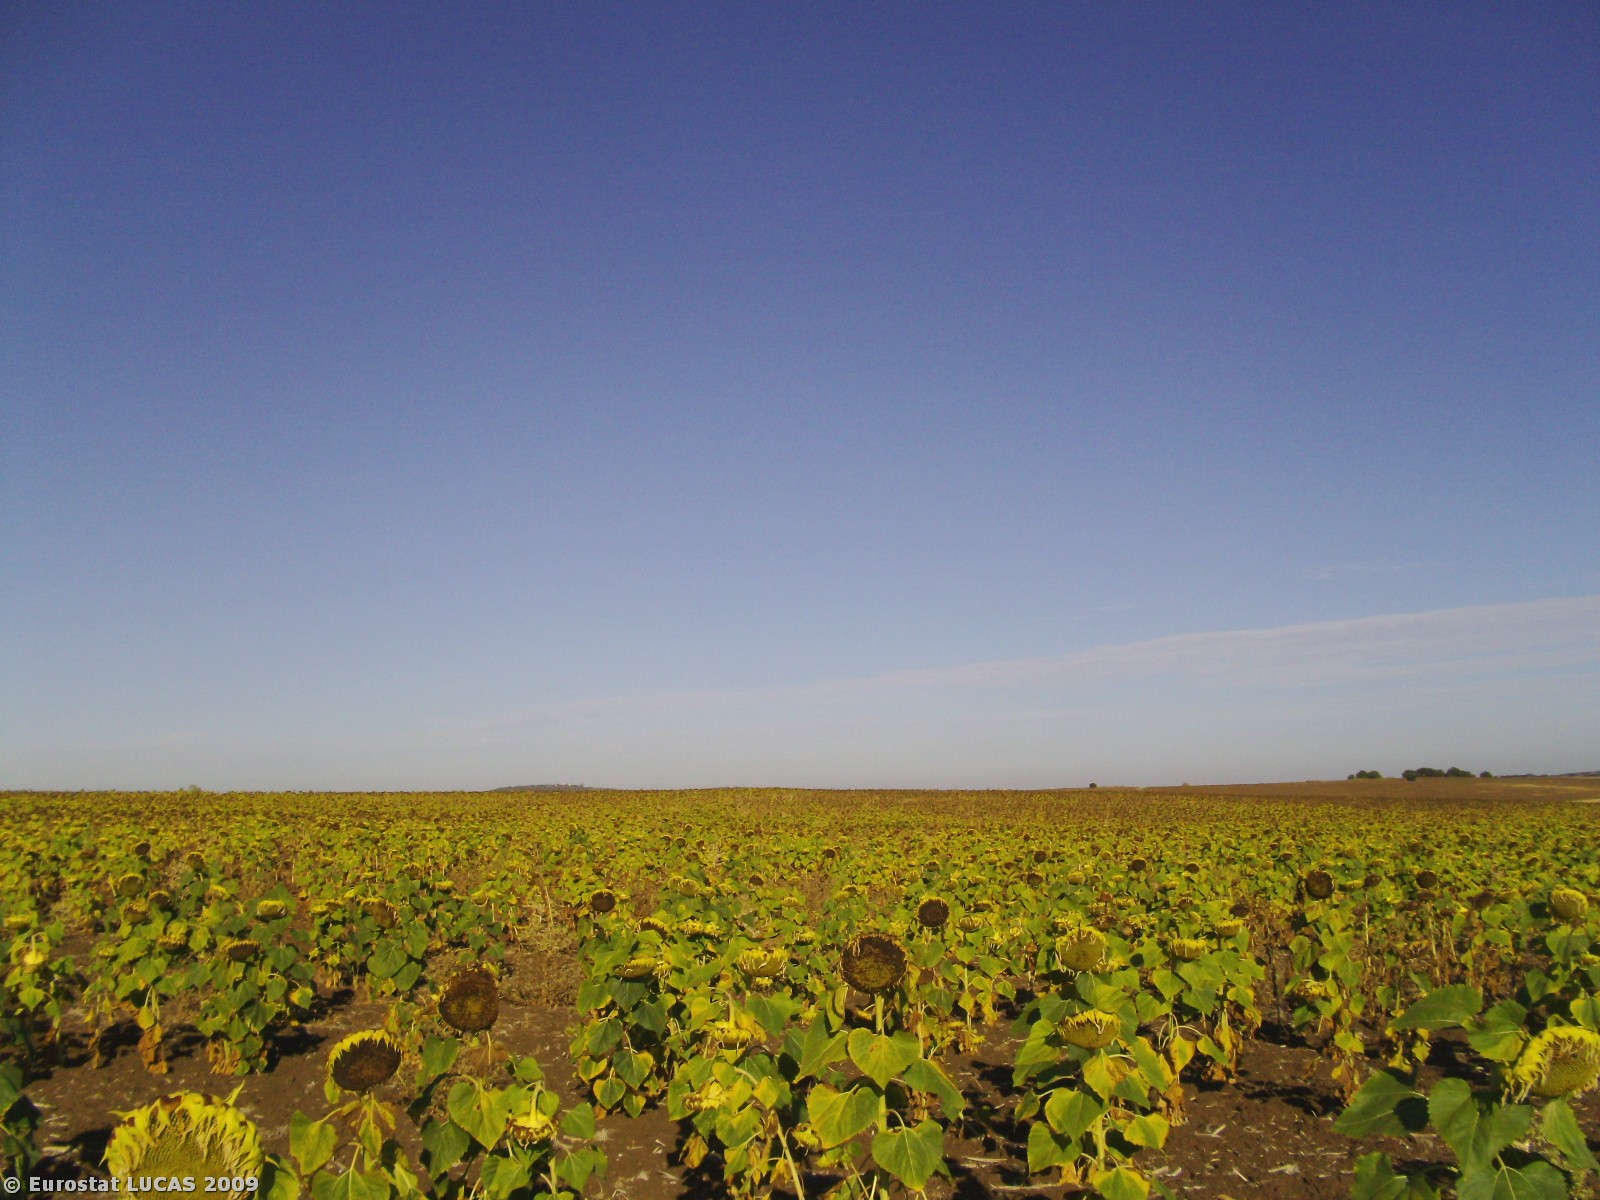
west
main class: Cropland
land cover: Sunflower
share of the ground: 50 - 75 %
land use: Agriculture (excluding fallow land and kitchen gardens)
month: August
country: PT
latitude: 37.9362
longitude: -7.5294
